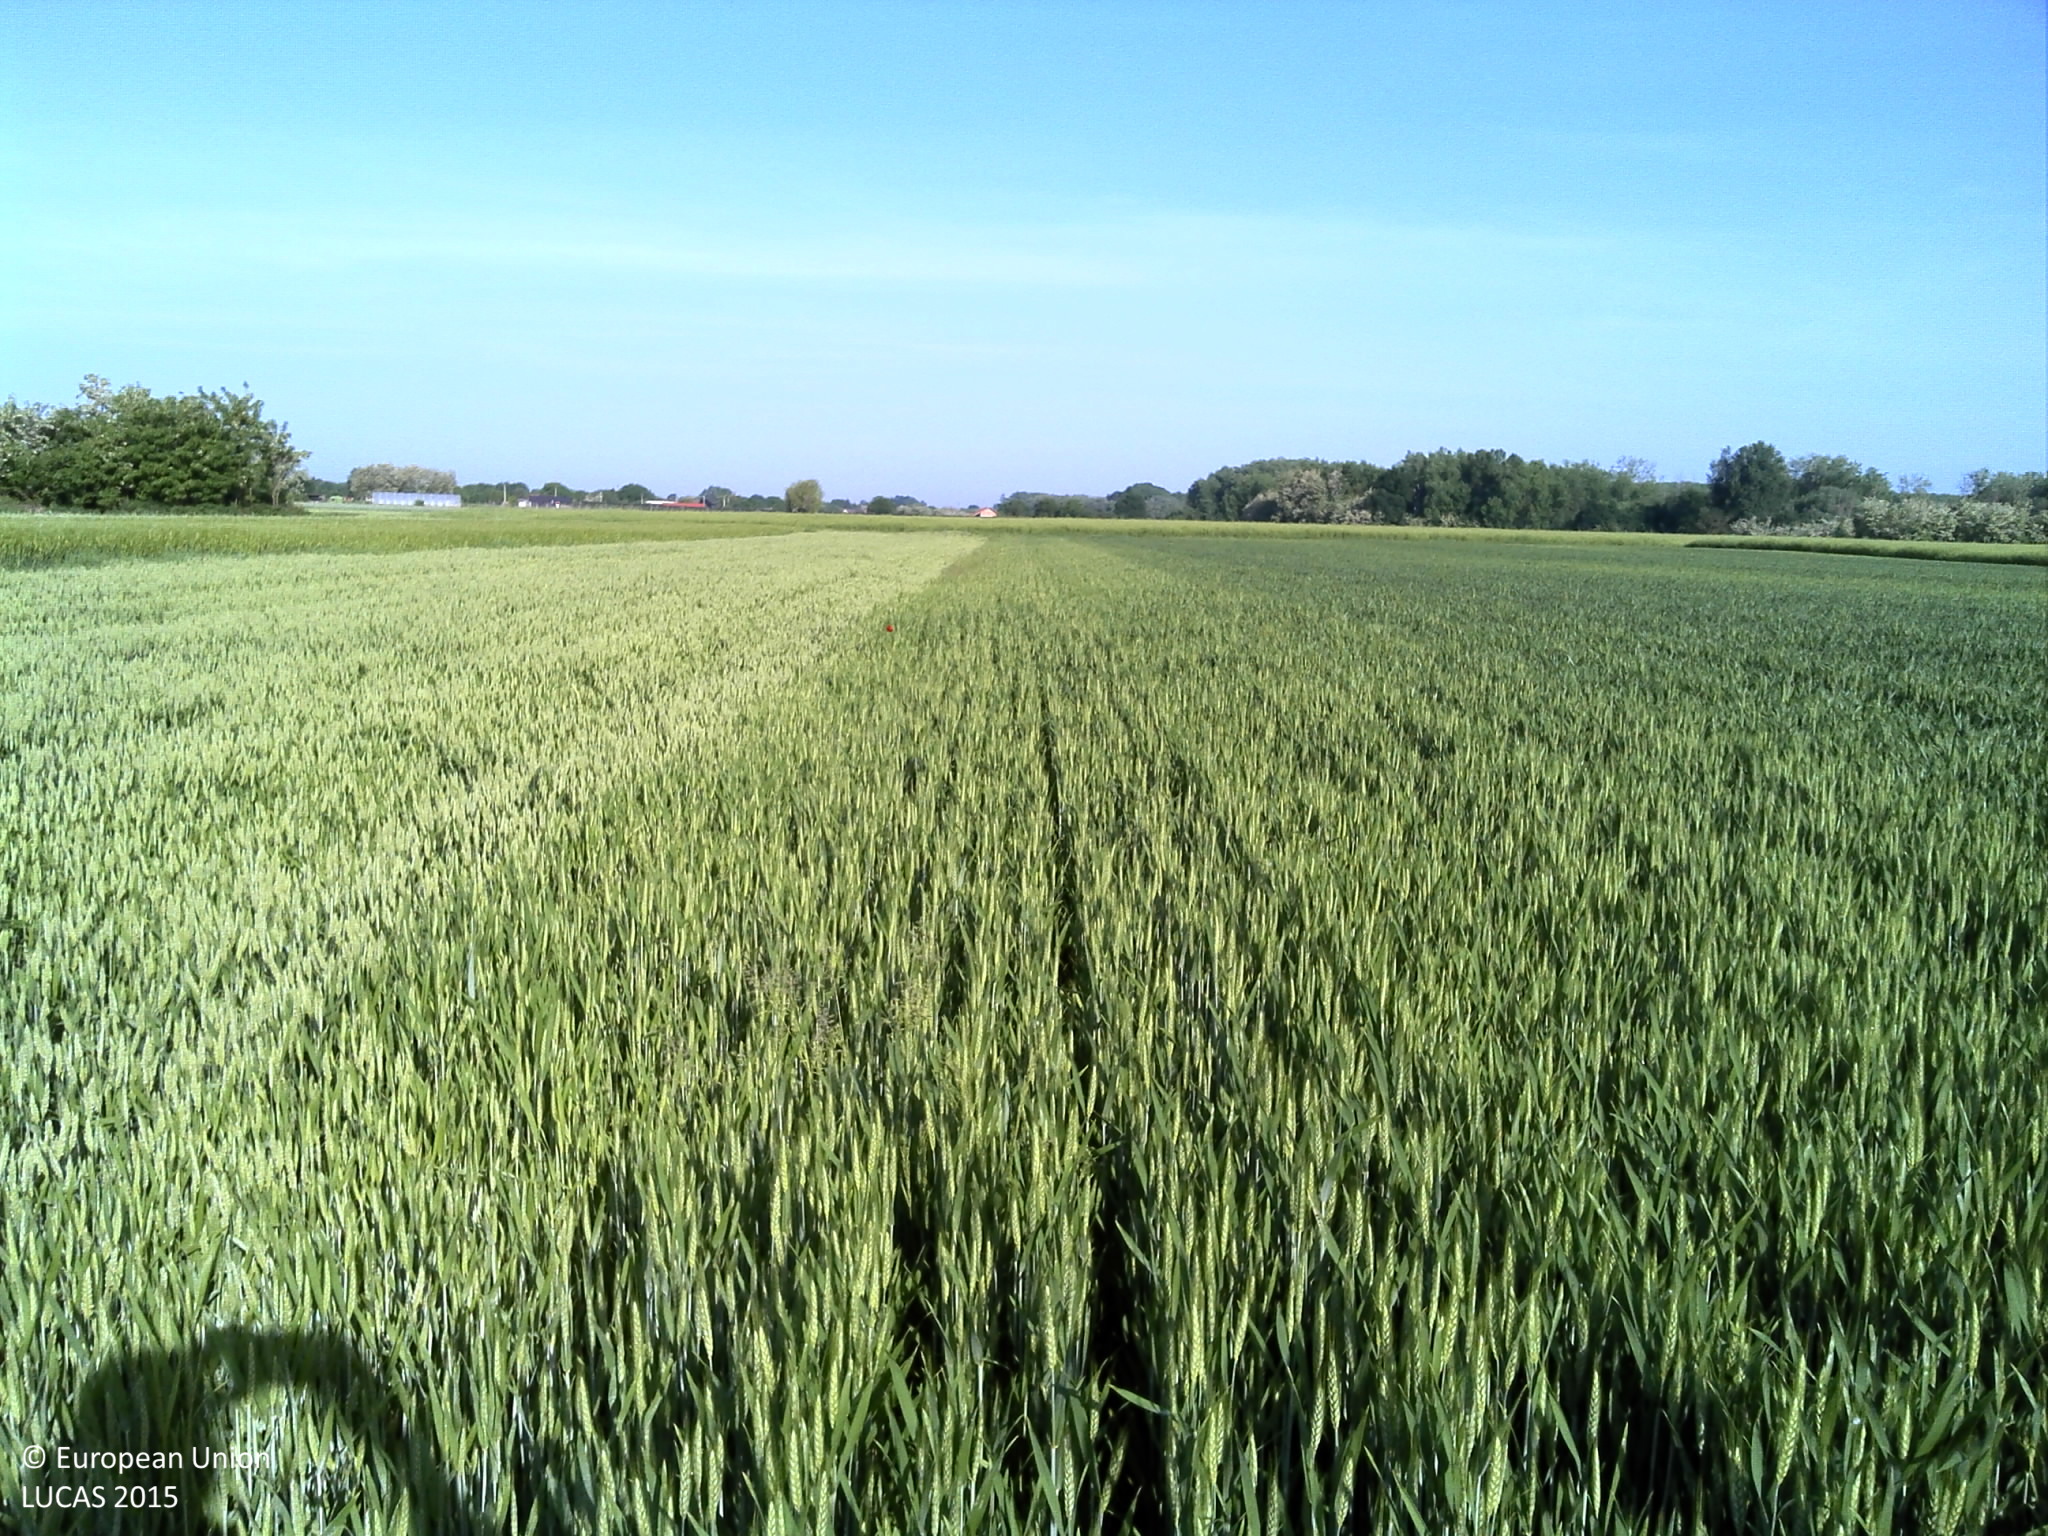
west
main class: Cropland
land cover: Common wheat
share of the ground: > 75 %
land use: Agriculture (excluding fallow land and kitchen gardens)
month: May
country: HR
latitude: 45.6133
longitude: 18.5088
